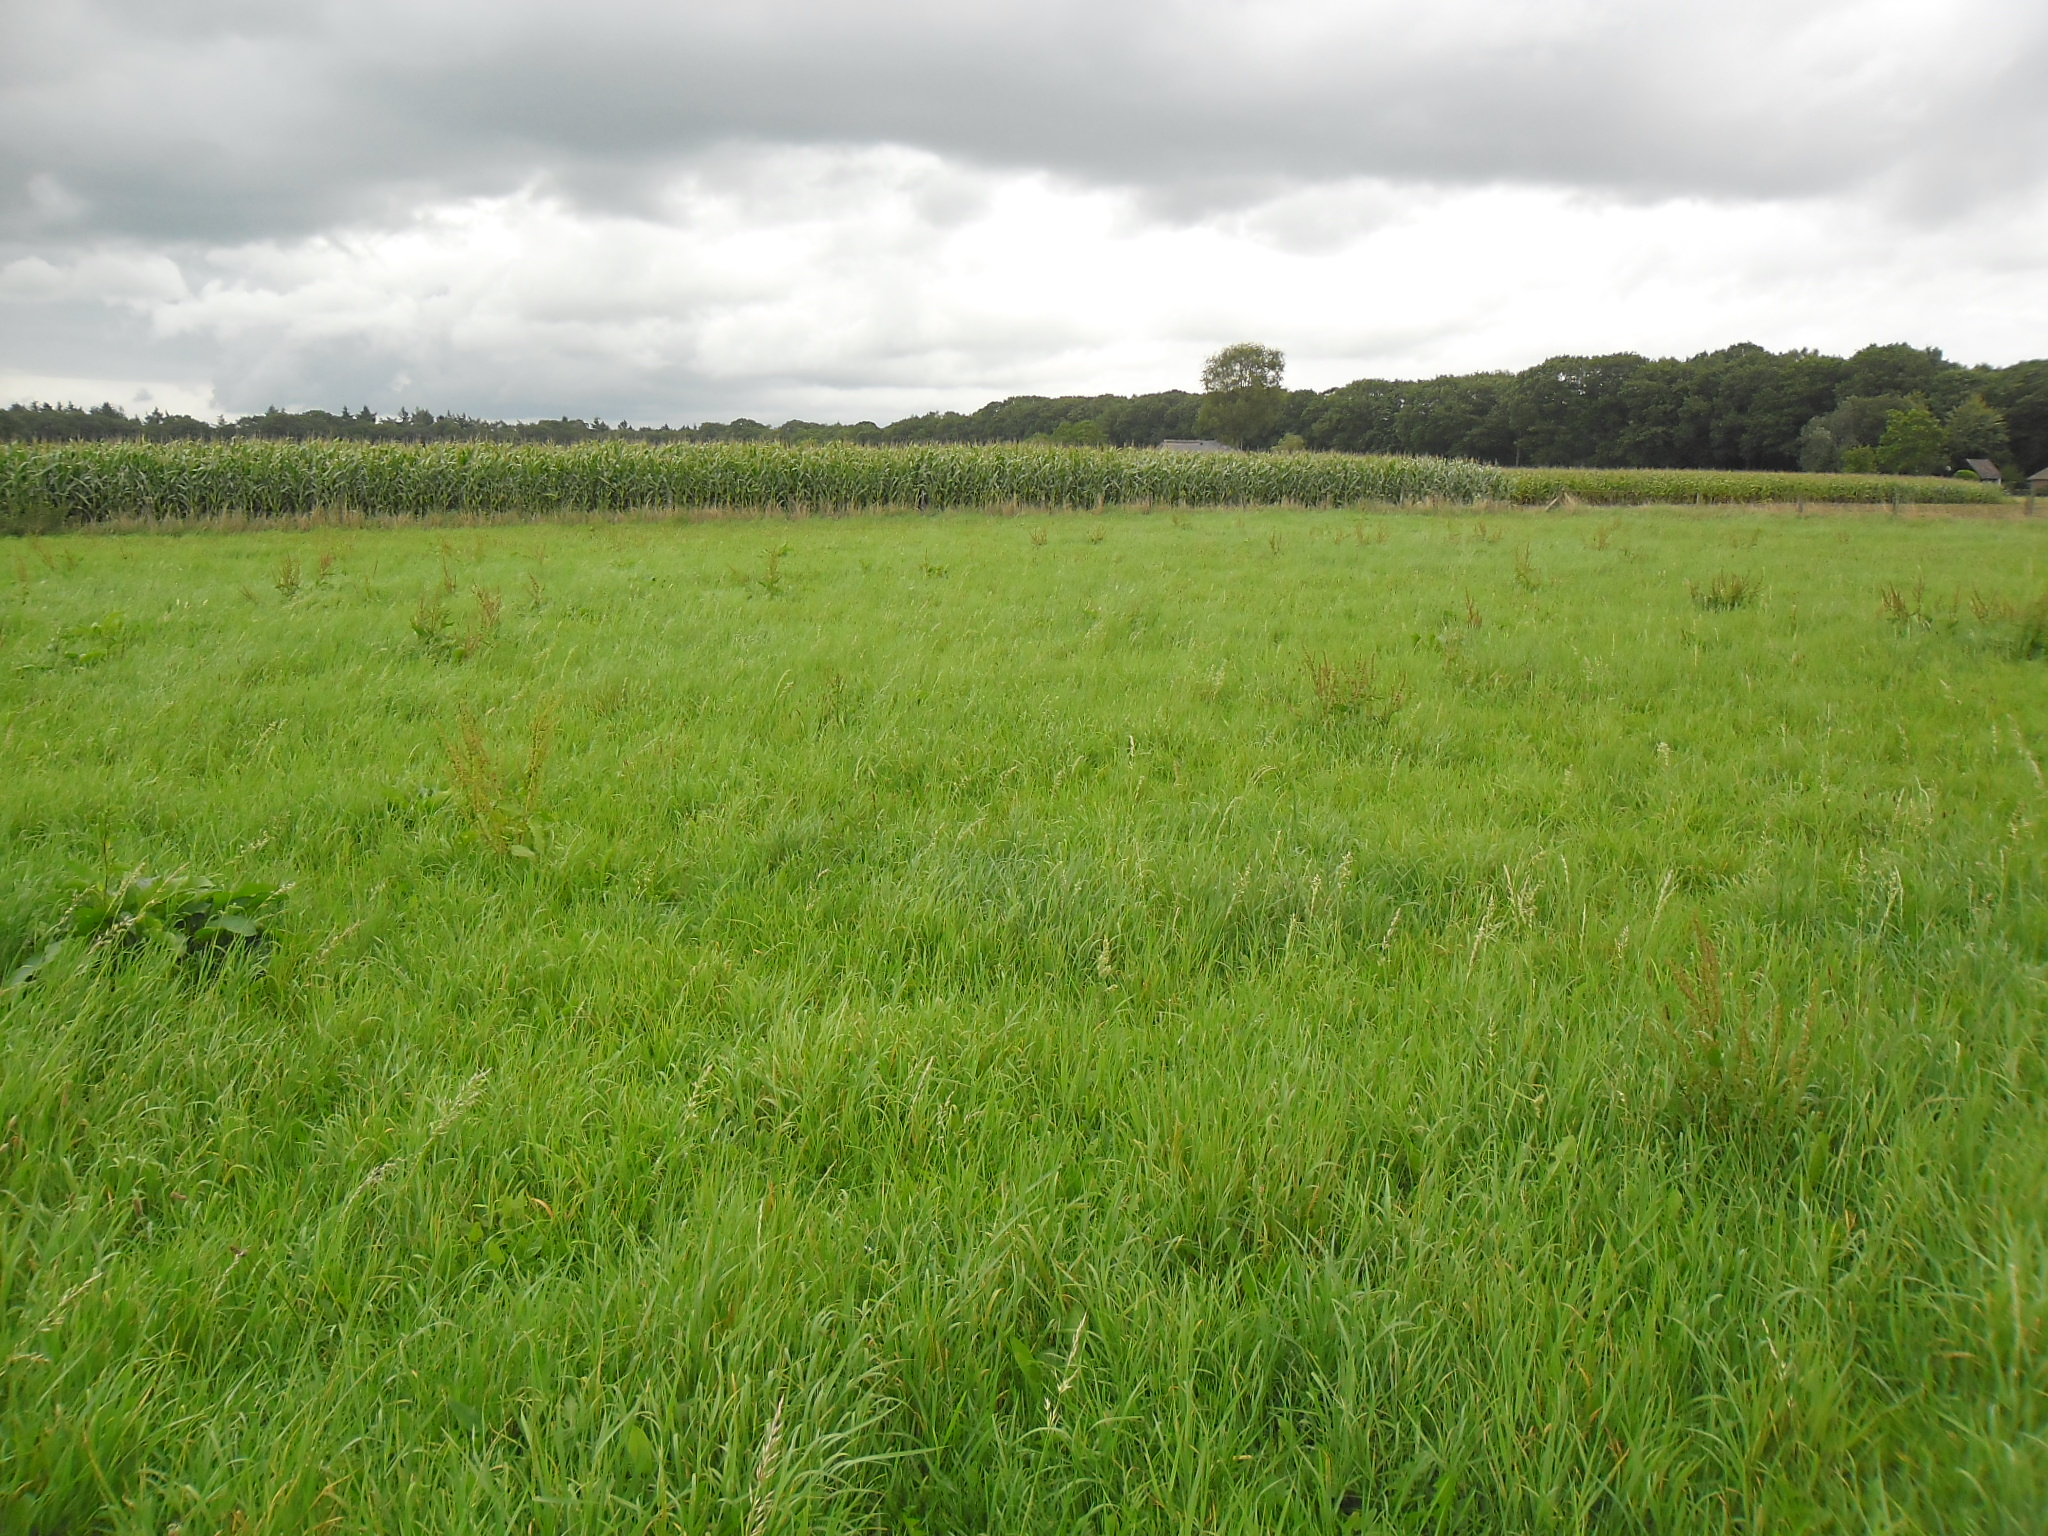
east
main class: Grassland
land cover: Grassland without tree/shrub cover
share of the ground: > 75 %
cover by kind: herbaceous plants 100 %
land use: Agriculture (excluding fallow land and kitchen gardens)
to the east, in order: Grassland without tree/shrub cover; Fences; Maize; Fences; Grassland without tree/shrub cover; Fences; Grassland without tree/shrub cover
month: September
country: NL
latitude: 52.2090
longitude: 6.2091
